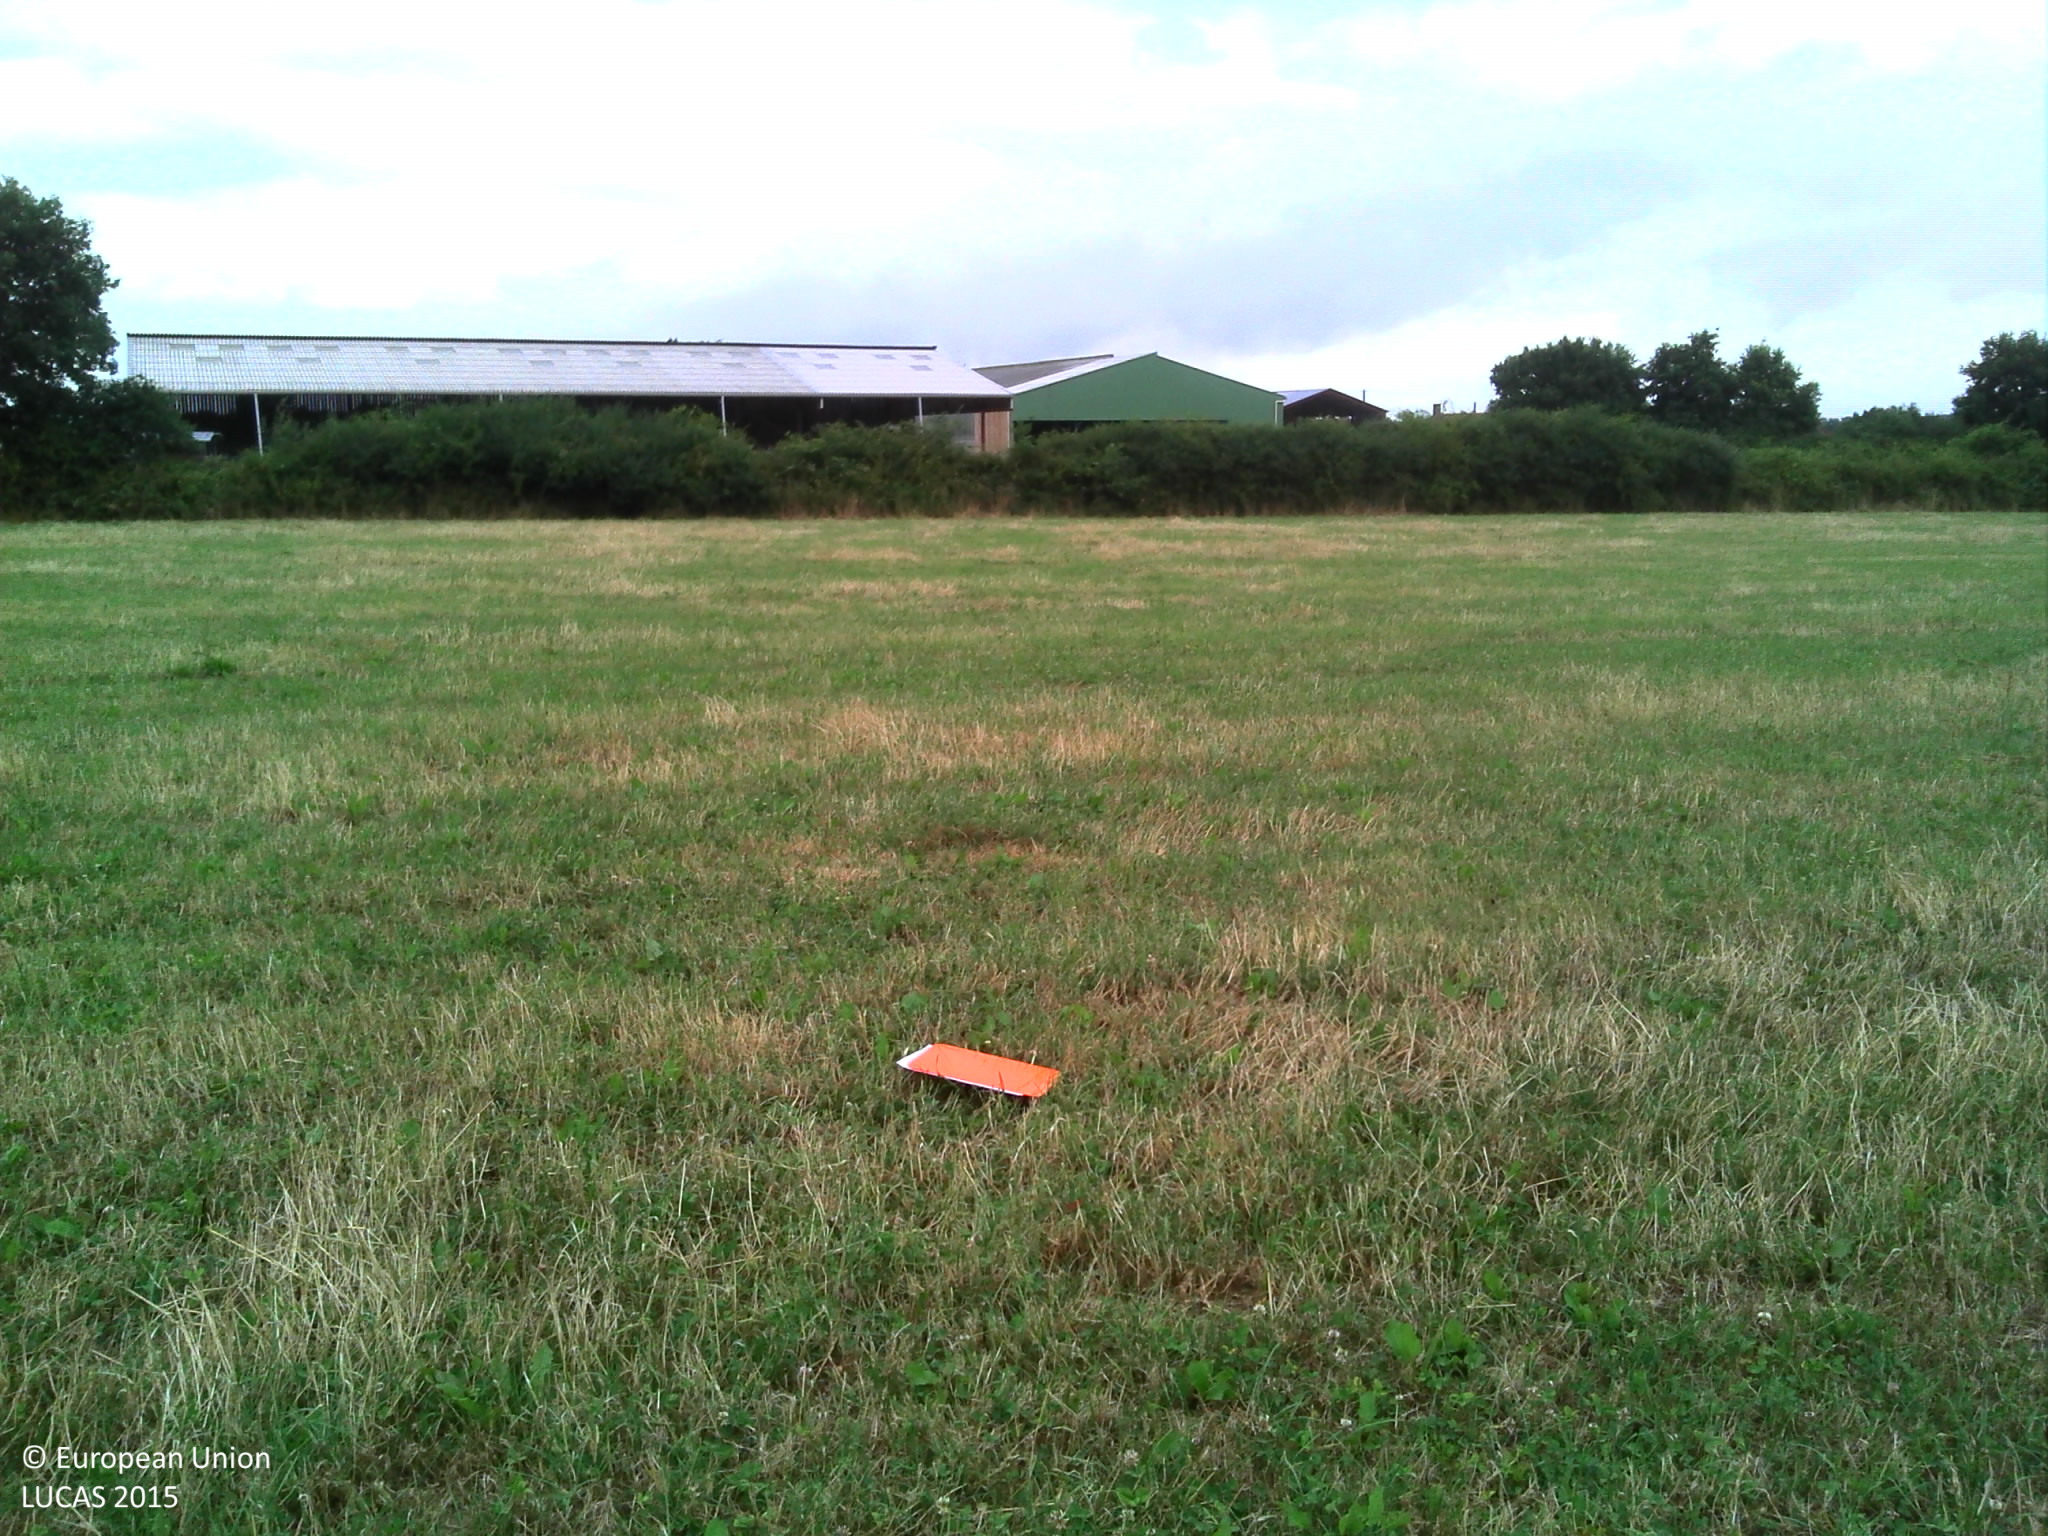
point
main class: Cropland
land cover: Temporary grasslands
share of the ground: > 75 %
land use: Agriculture (excluding fallow land and kitchen gardens)
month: July
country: FR
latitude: 47.1101
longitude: -1.8399
